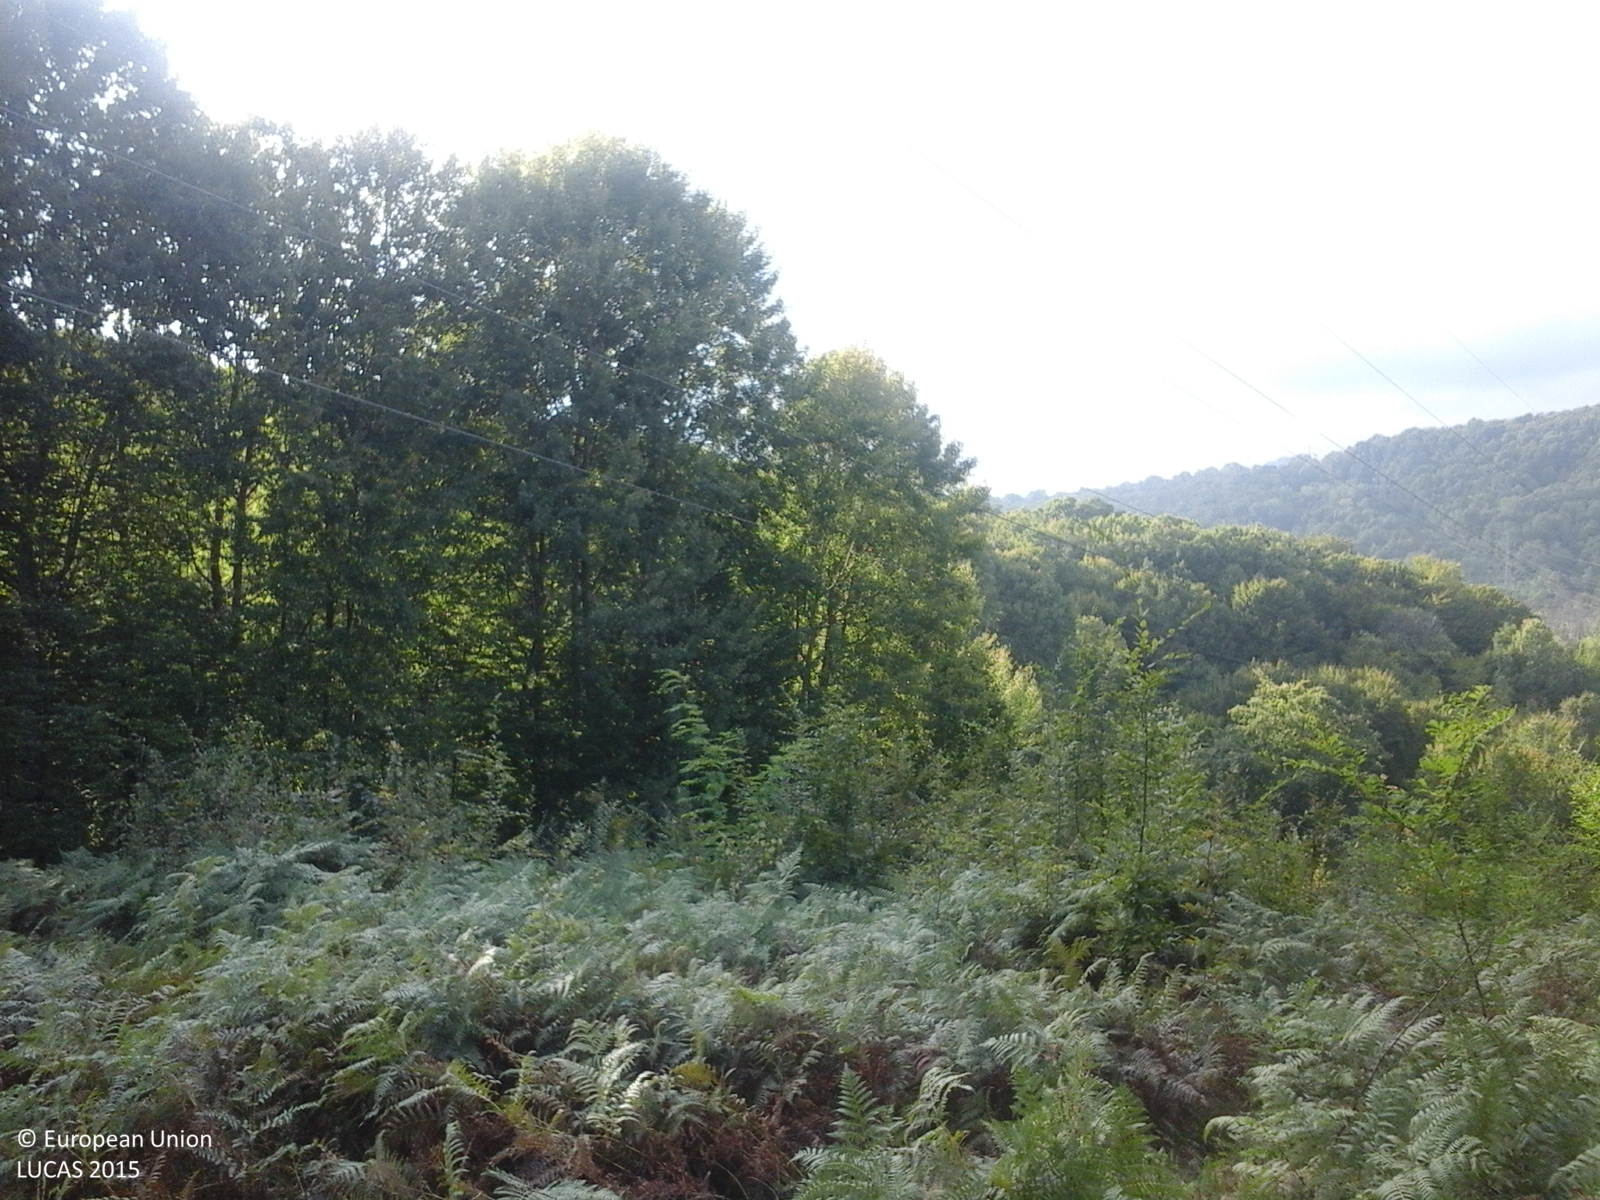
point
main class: Shrubland
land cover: Shrubland with sparse tree cover
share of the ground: > 75 %
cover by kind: shrubs 95 %, broadleaved forest trees 5 %
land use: Semi-natural and natural areas not in use
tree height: < 5 m
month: September
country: RO
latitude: 45.0866
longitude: 22.9447
